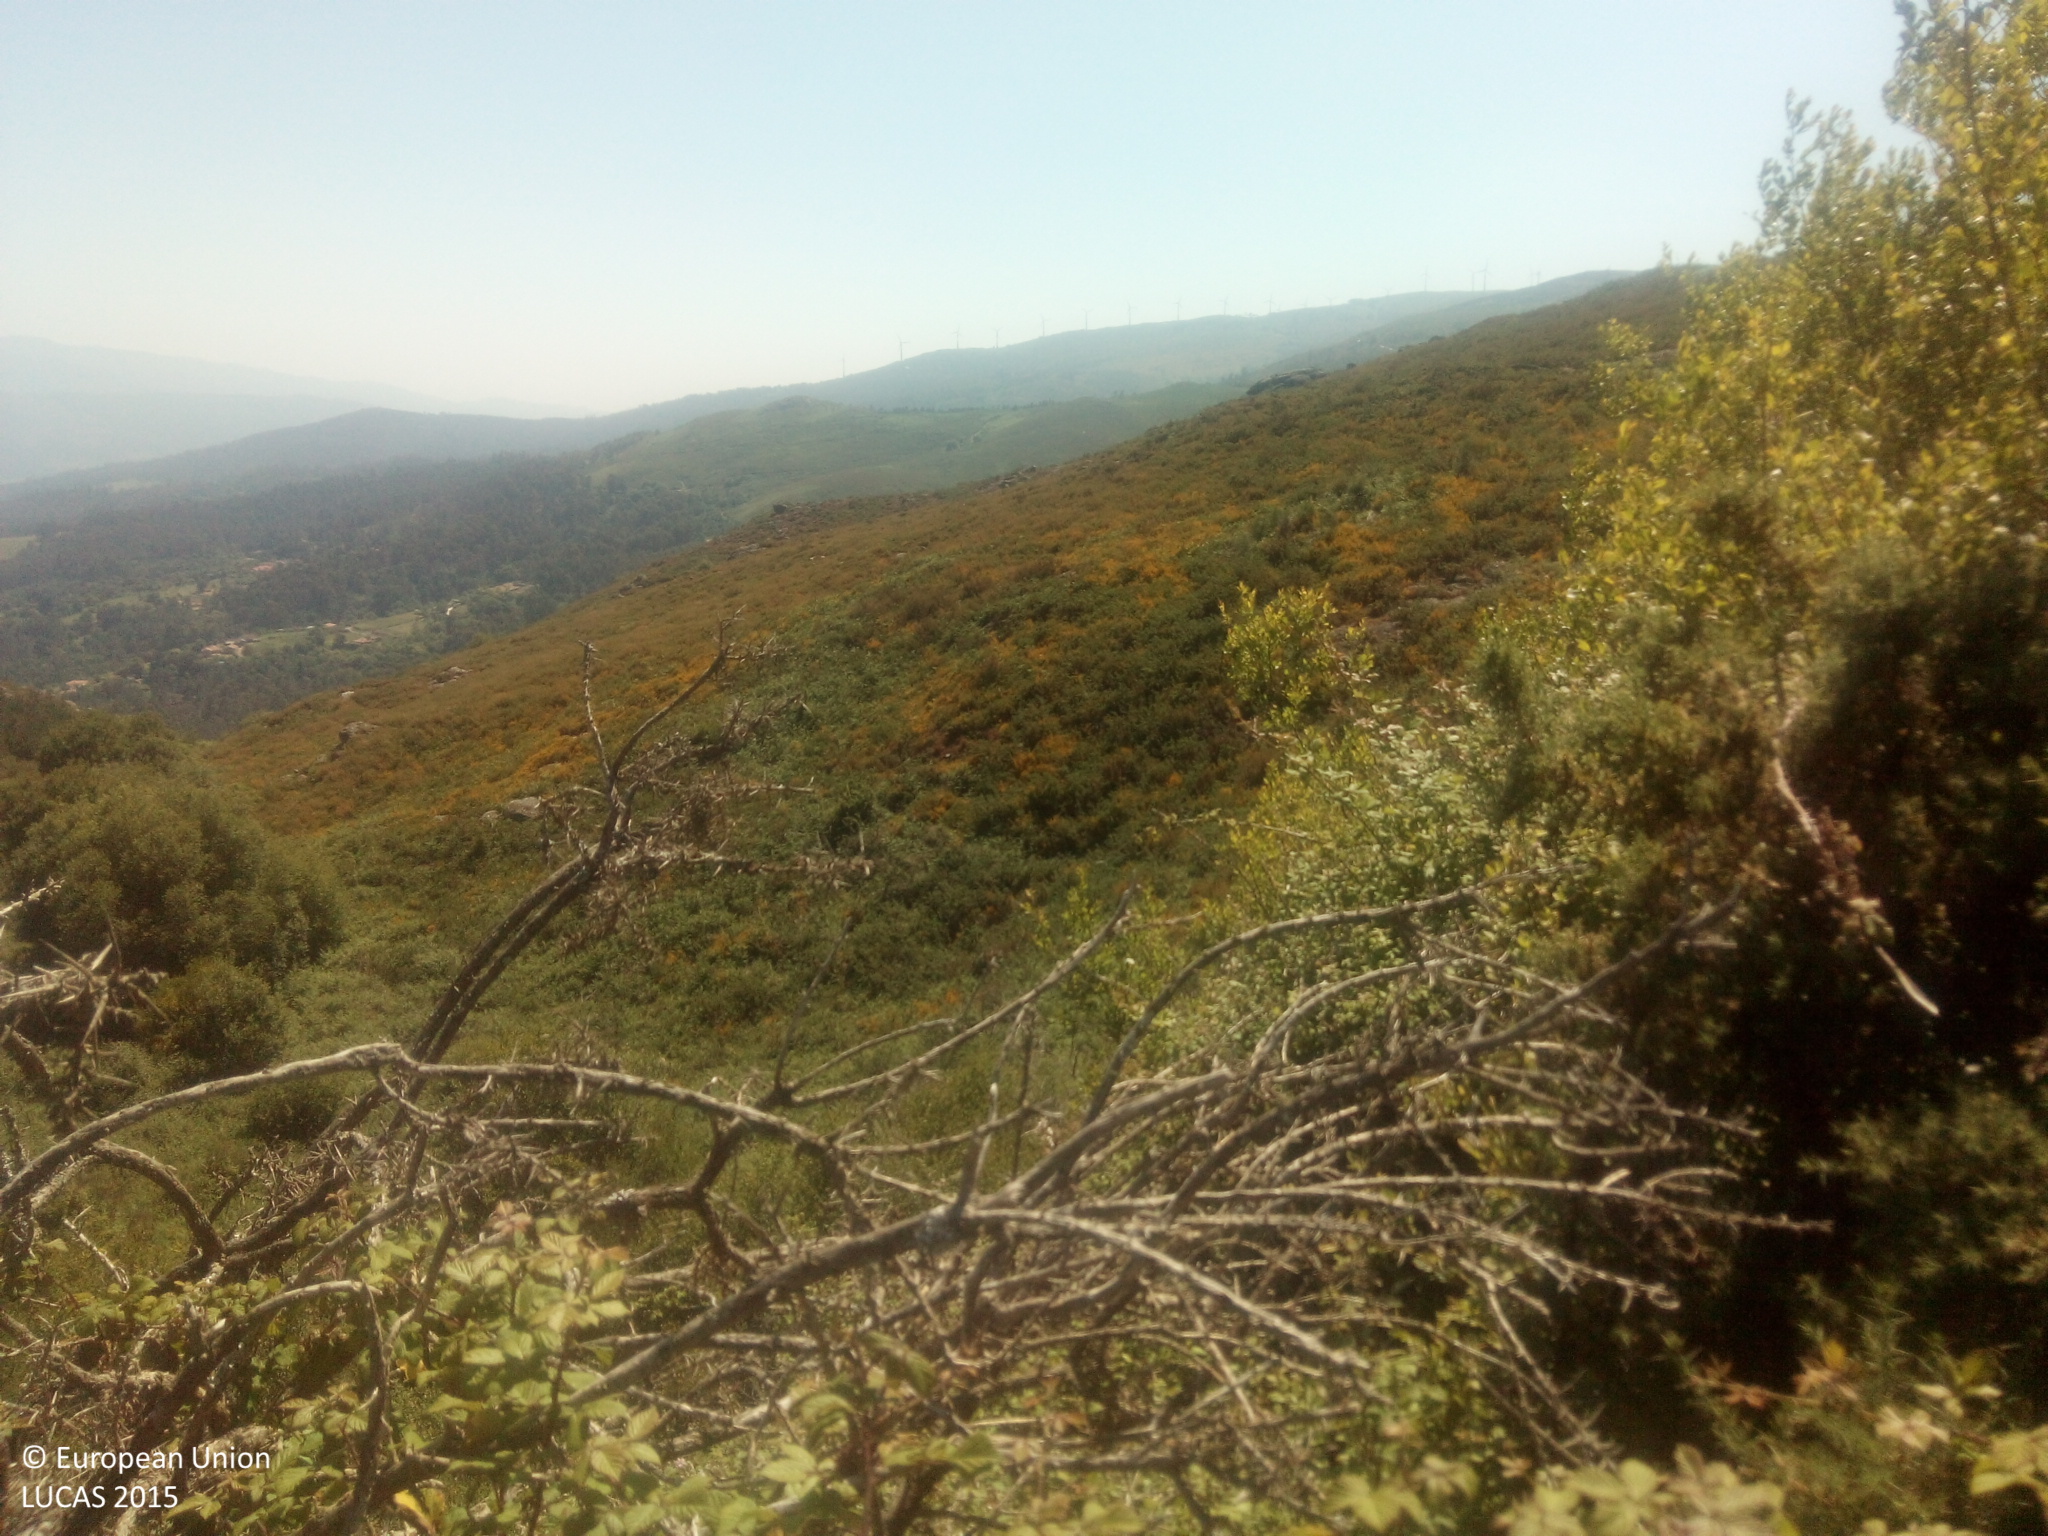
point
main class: Shrubland
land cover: Shrubland without tree cover
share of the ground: > 75 %
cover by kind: shrubs 70 %, consolidated bare surface 30 %
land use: Semi-natural and natural areas not in use
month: June
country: ES
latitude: 42.1869
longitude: -8.3110
